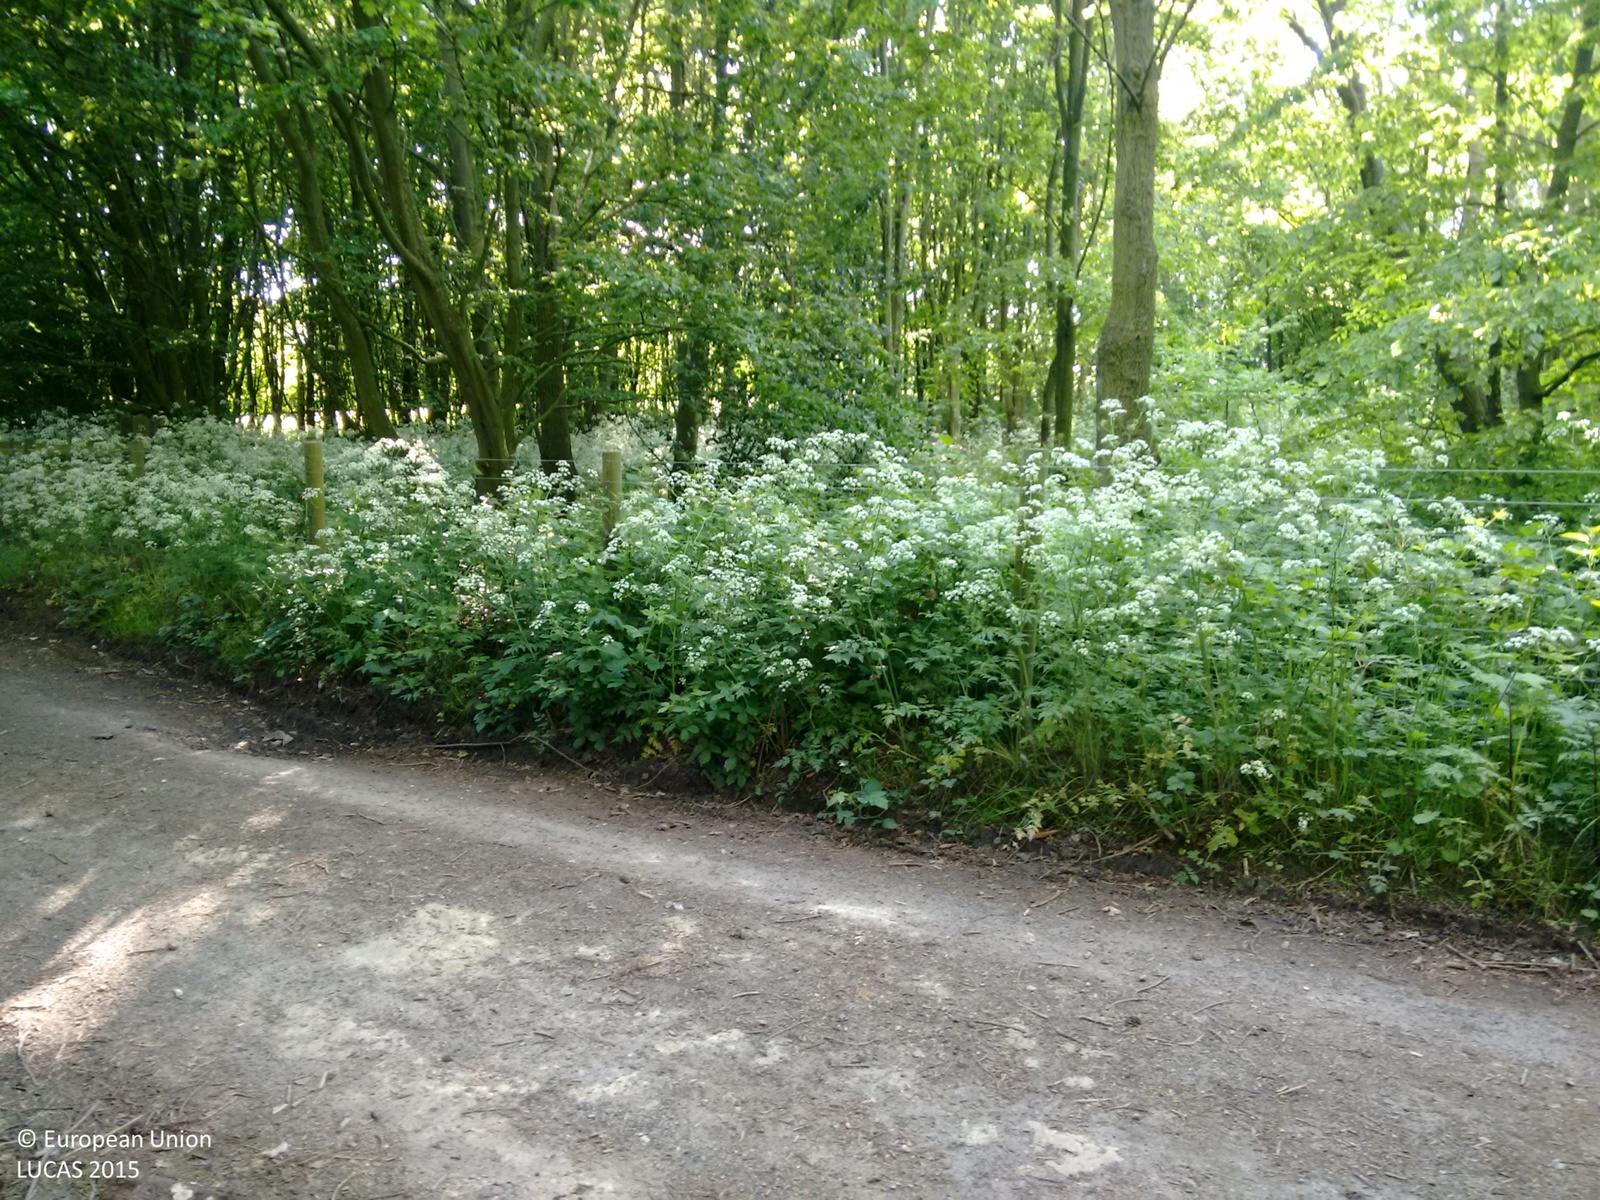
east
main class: Woodland
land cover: Broadleaved woodland
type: mesophytic deciduous forest
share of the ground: > 75 %
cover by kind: broadleaved forest trees 90 %, shrubs 10 %
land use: Amenities, museums, leisure
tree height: > 5 m
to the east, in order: Broadleaved woodland; Tracks; Fences; Broadleaved woodland; Fences; Grassland without tree/shrub cover; Fences; Broadleaved woodland
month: May
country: GB
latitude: 51.1649
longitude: 1.2121
